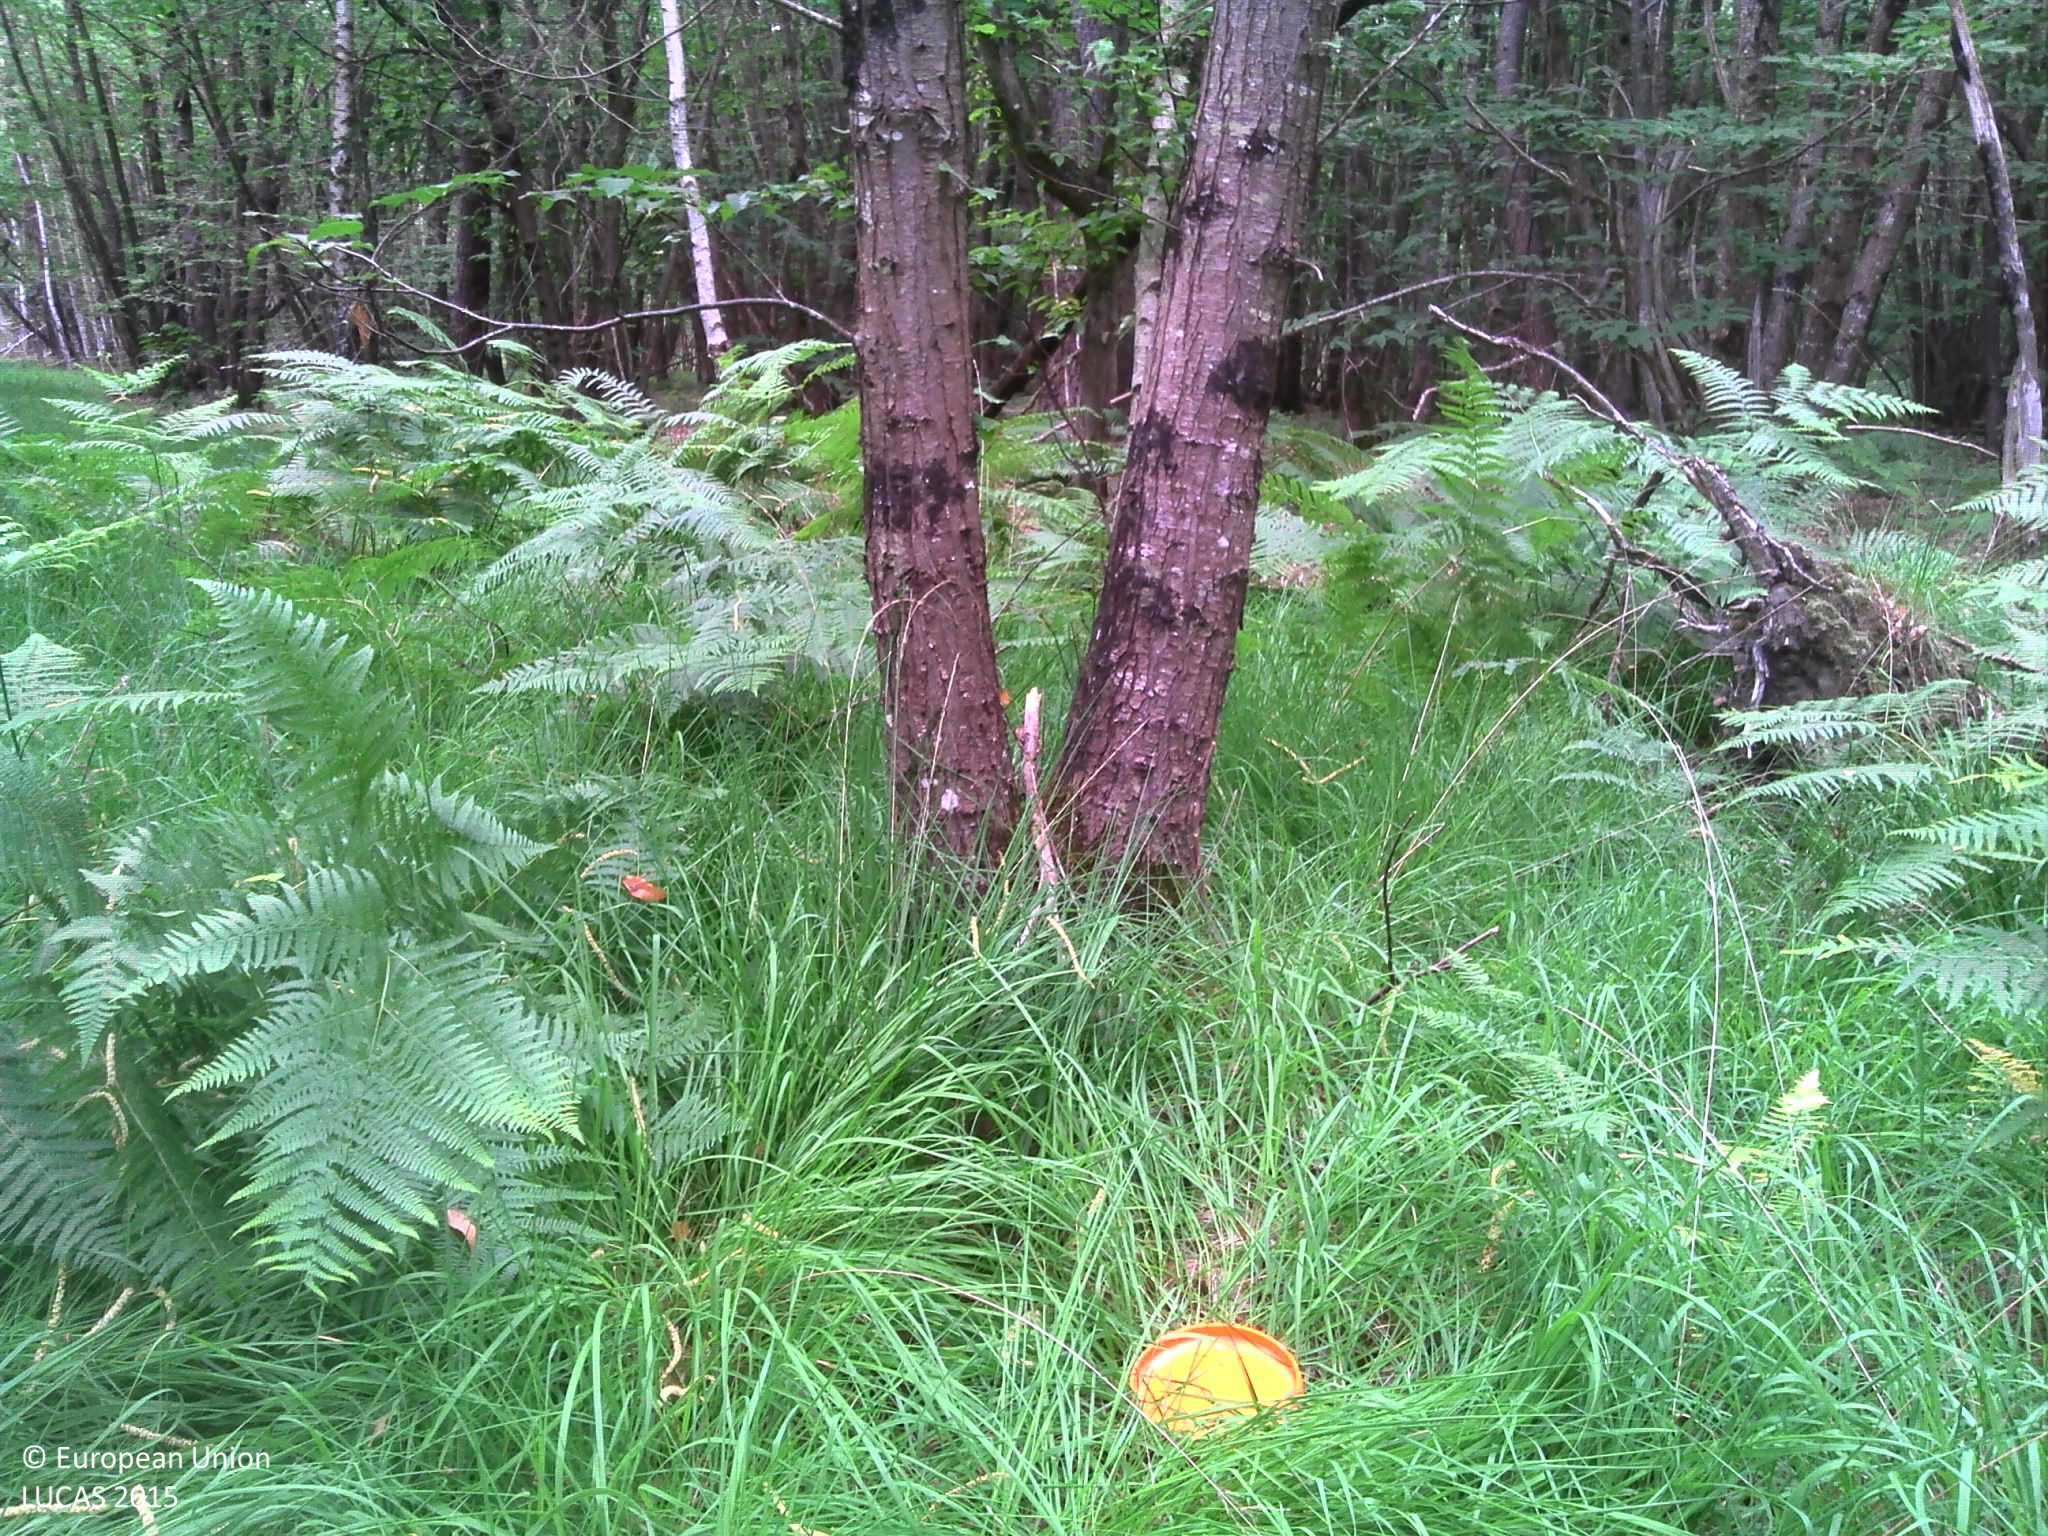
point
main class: Woodland
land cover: Pine dominated mixed woodland
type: acidophilous oak and oak-birch forest
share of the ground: > 75 %
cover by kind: broadleaved forest trees 40 %, coniferous forest trees 30 %, herbaceous plants 20 %, shrubs 5 %, lichens and mosses 5 %
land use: Forestry
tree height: > 5 m
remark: Fire break
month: July
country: FR
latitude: 47.3099
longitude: 0.1480
